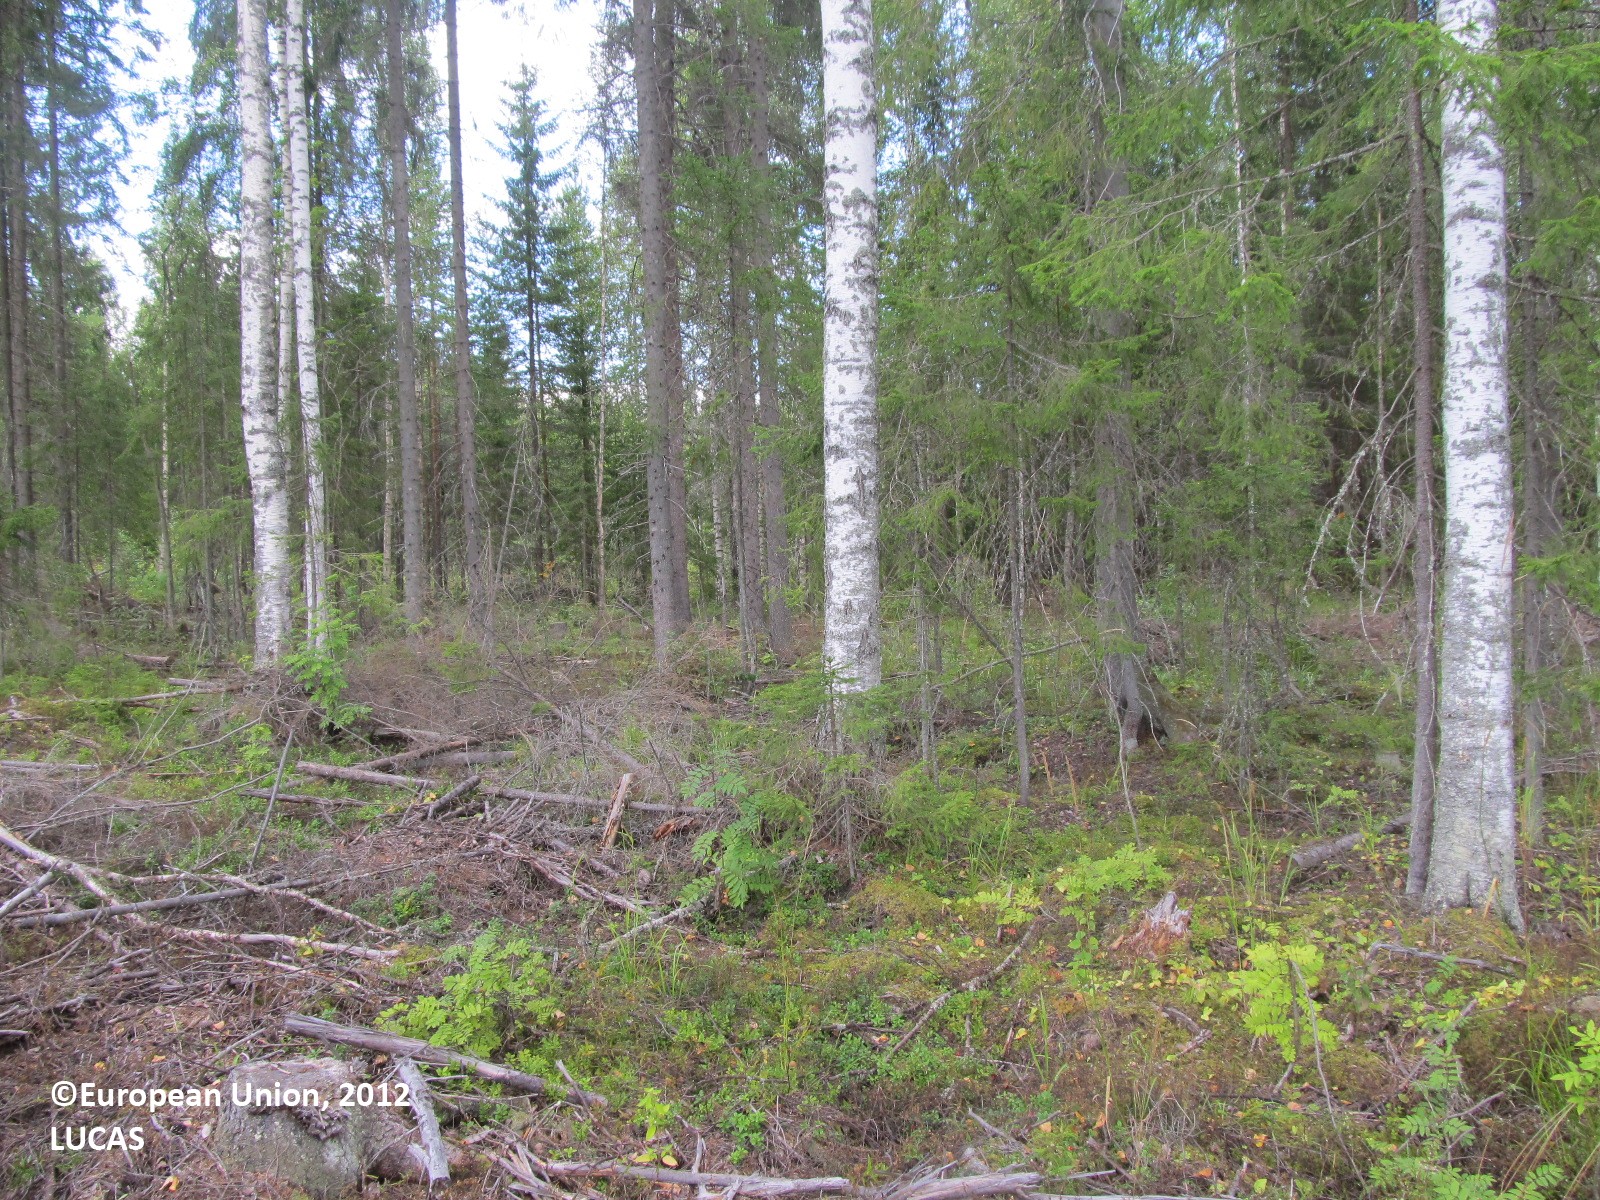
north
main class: Woodland
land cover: Spruce dominated mixed woodland
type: boreal forest
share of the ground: 25 - 50 %
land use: Forestry
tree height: > 5 m
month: August
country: FI
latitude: 62.4533
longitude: 27.7558
